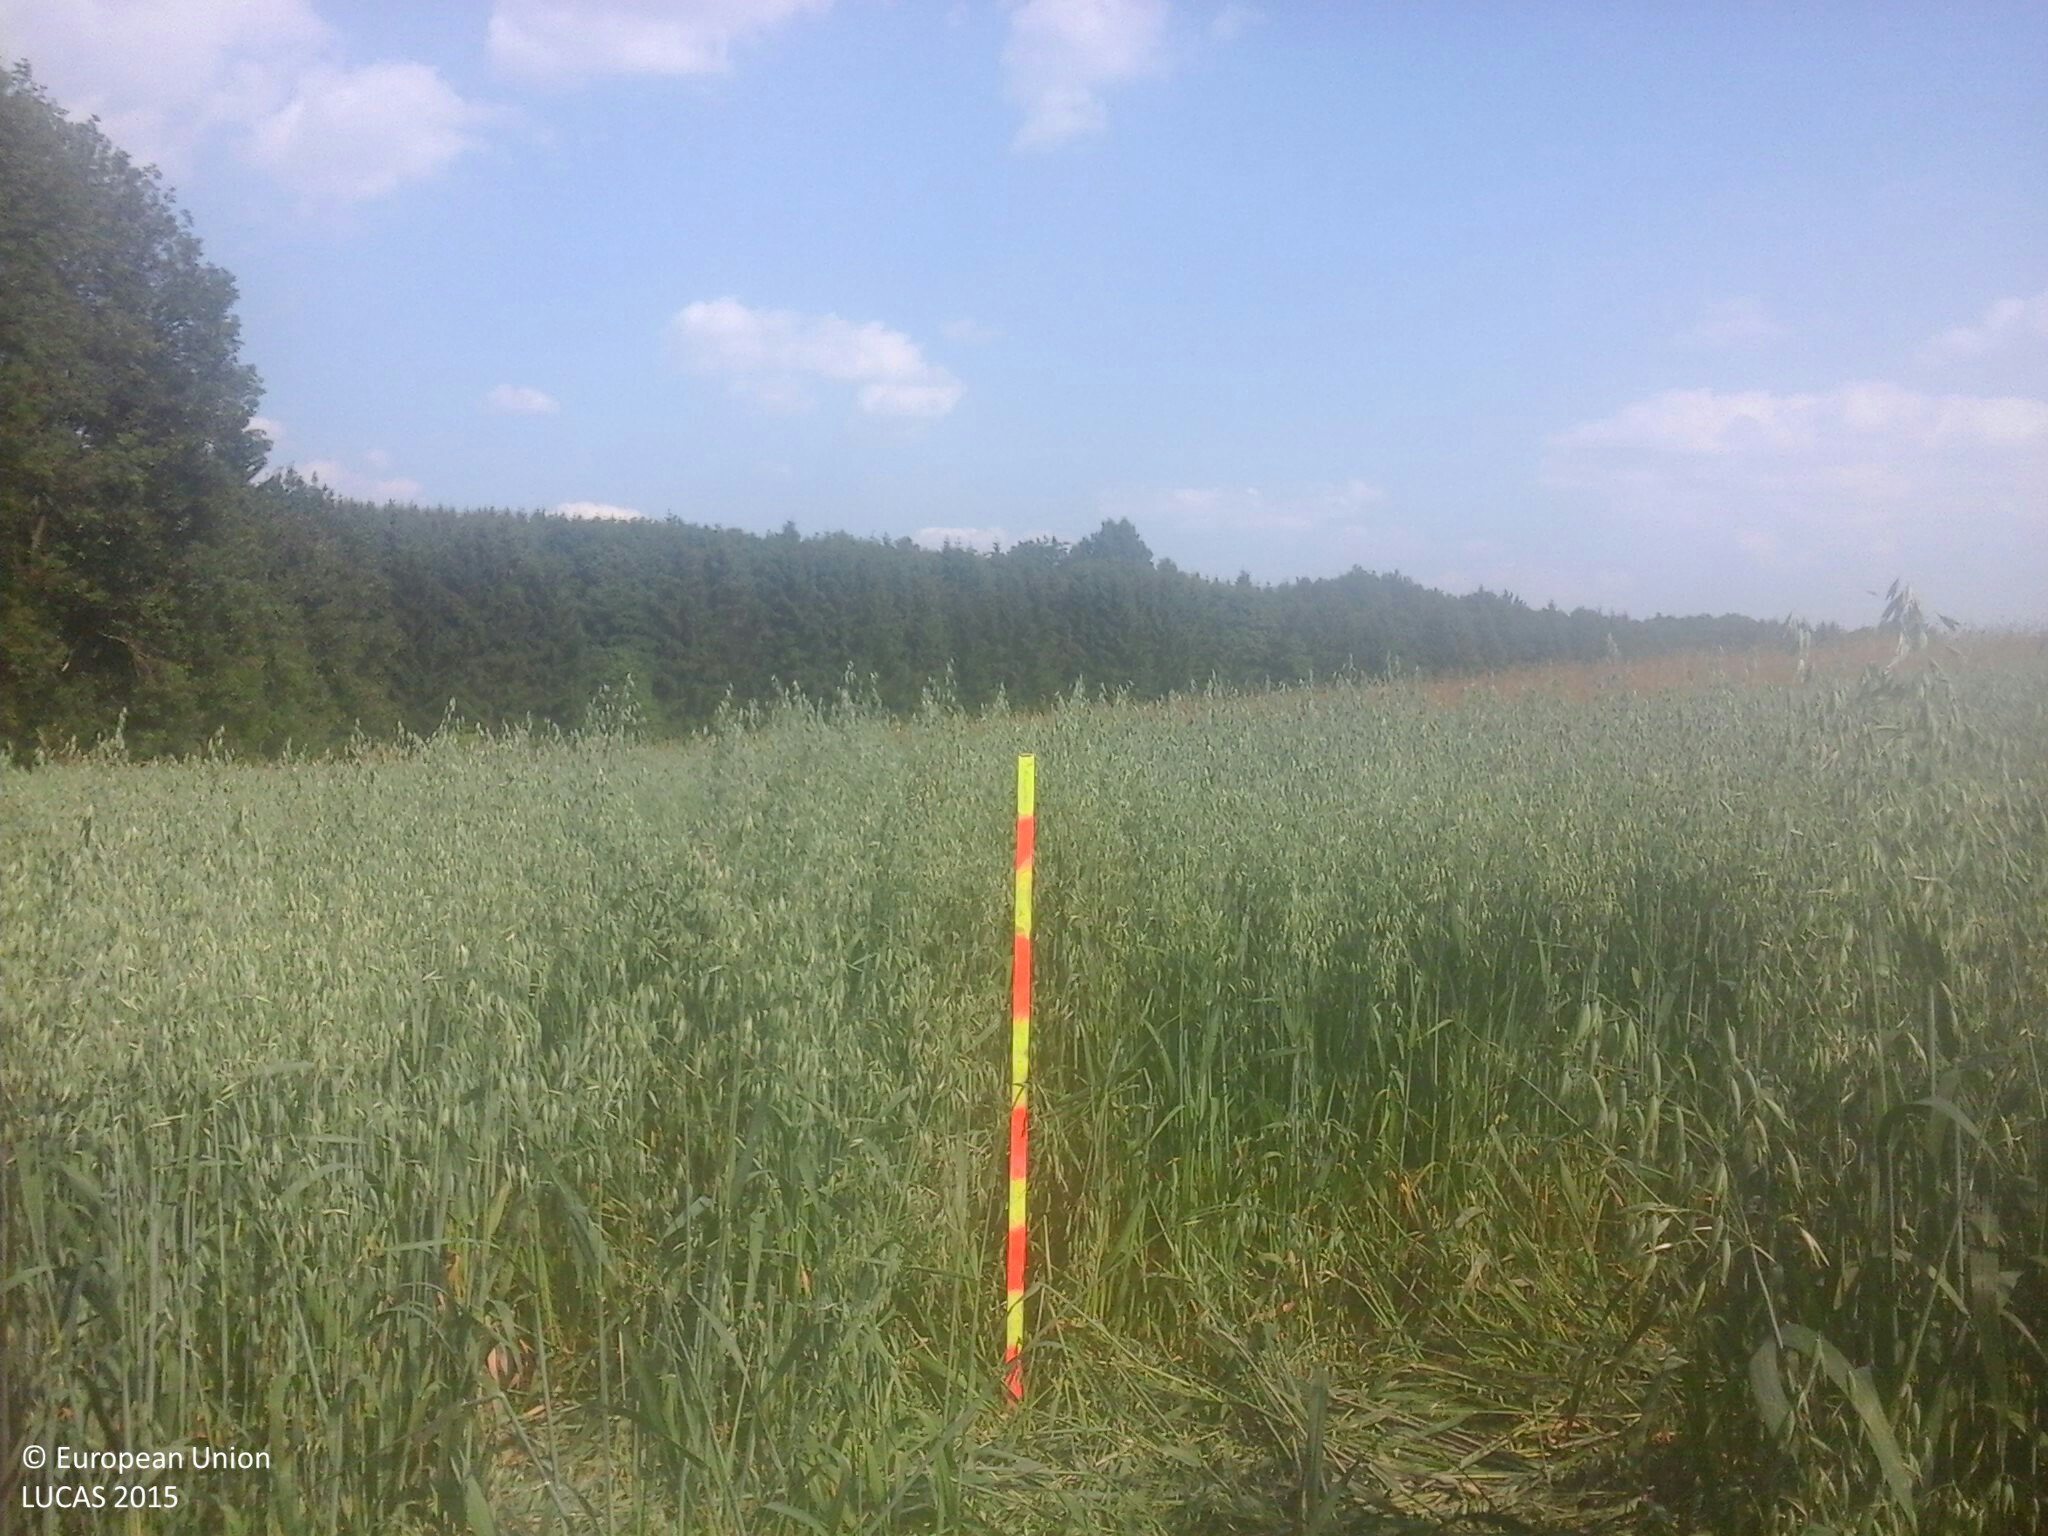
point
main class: Cropland
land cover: Oats
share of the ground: > 75 %
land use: Agriculture (excluding fallow land and kitchen gardens)
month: July
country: HU
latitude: 47.2905
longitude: 17.8770
